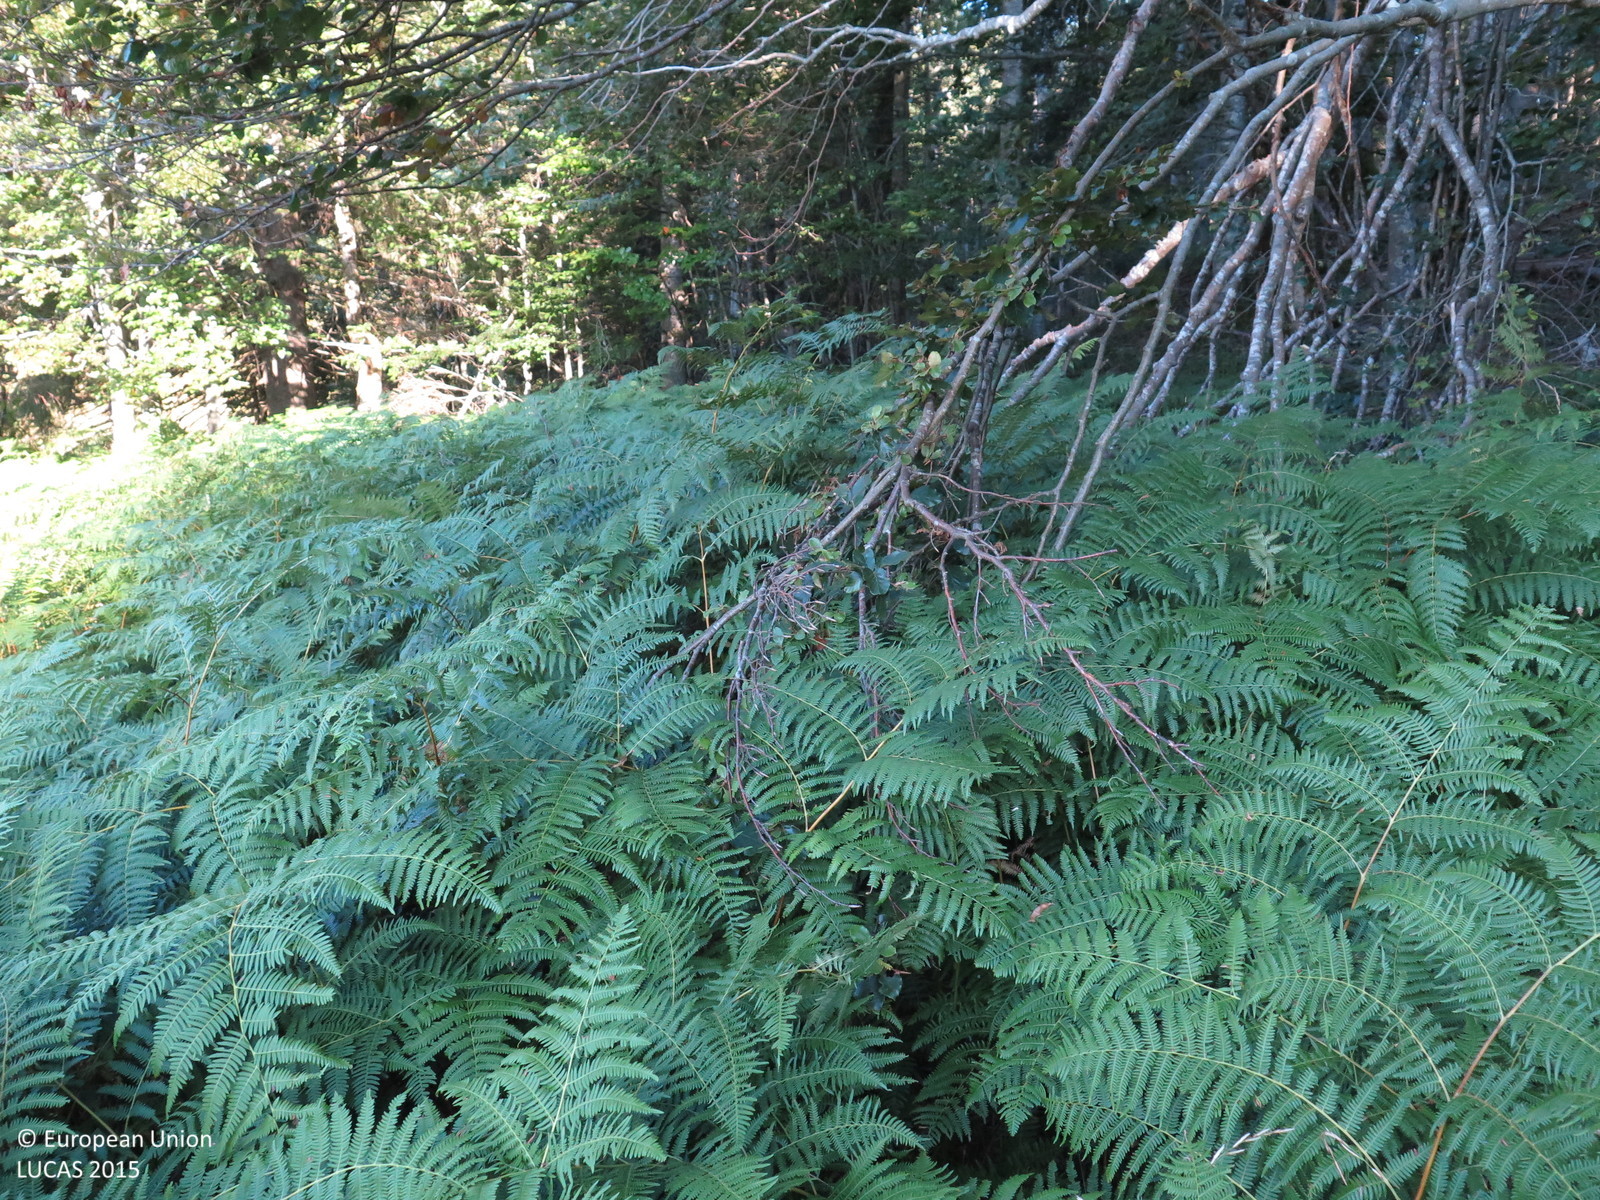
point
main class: Woodland
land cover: Other mixed woodland
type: mountainous beech forest
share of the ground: > 75 %
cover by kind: coniferous forest trees 75 %, broadleaved forest trees 25 %
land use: Forestry
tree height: > 5 m
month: September
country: HR
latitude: 45.5118
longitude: 14.6163
